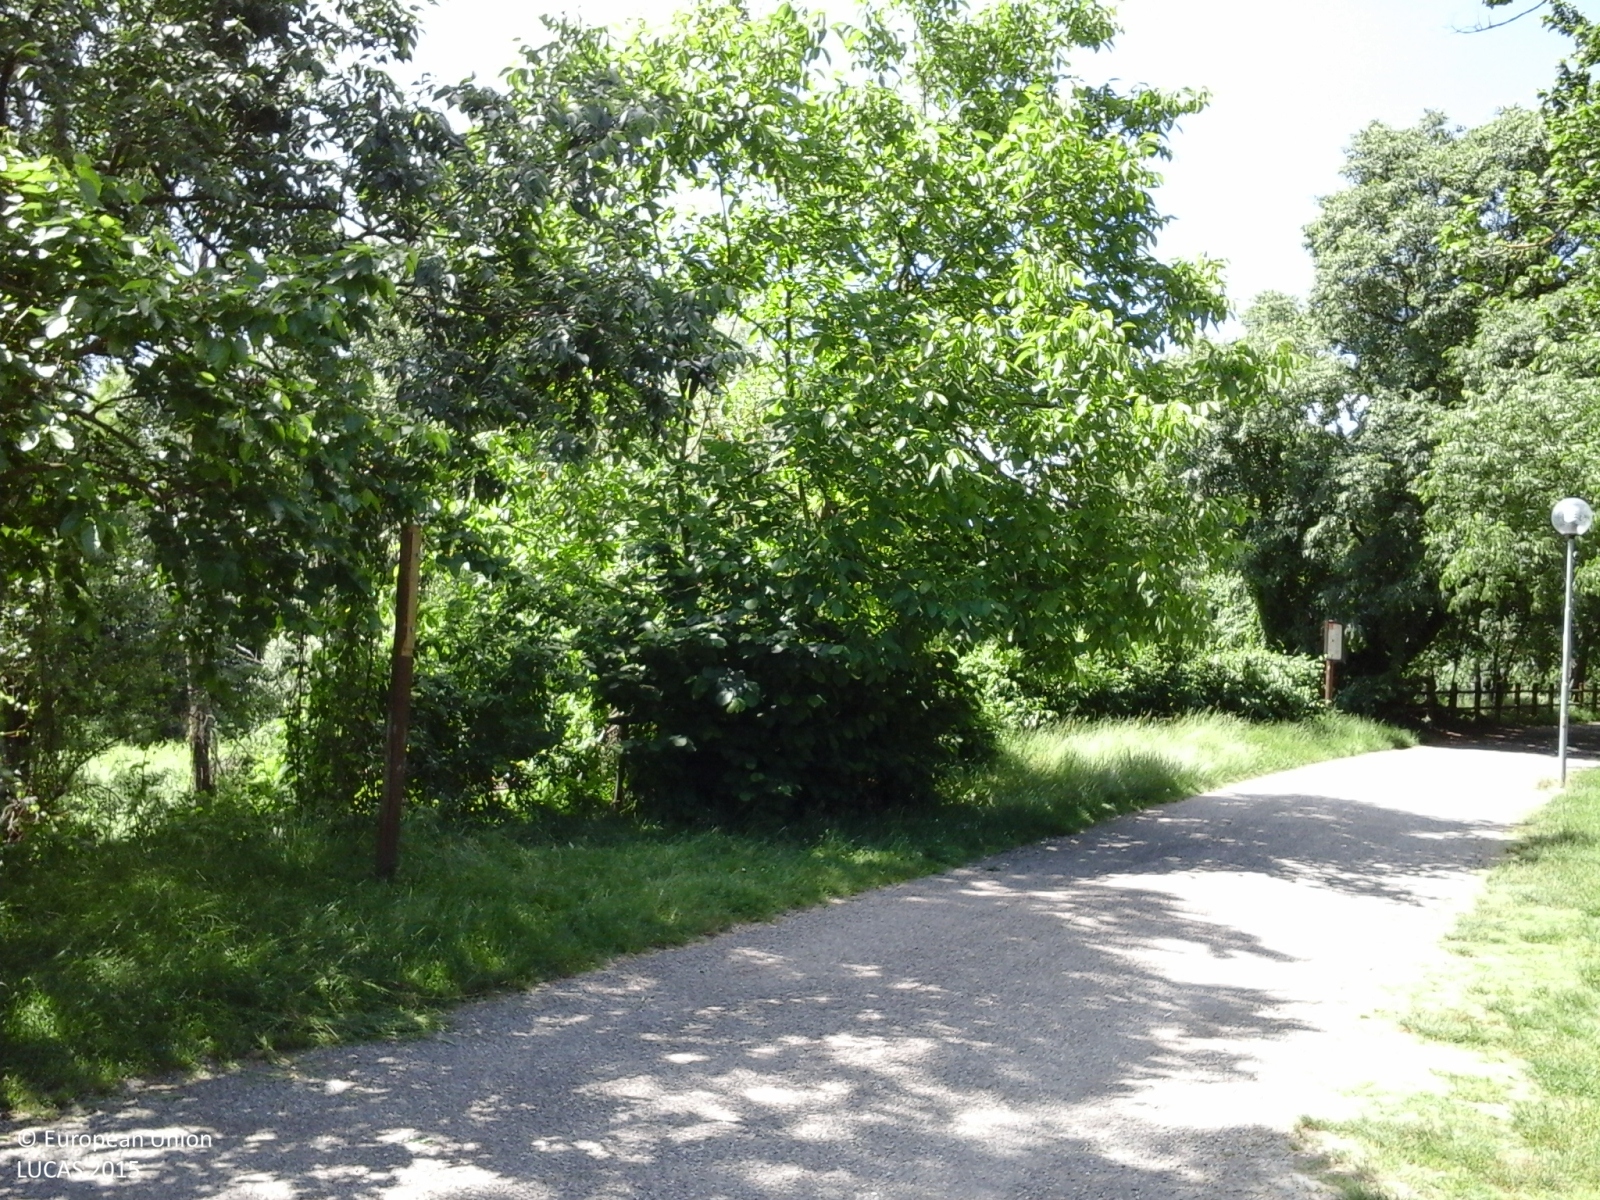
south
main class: Grassland
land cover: Grassland without tree/shrub cover
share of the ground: > 75 %
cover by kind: herbaceous plants 100 %
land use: Amenities, museums, leisure
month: May
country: IT
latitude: 44.6733
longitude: 10.6168
